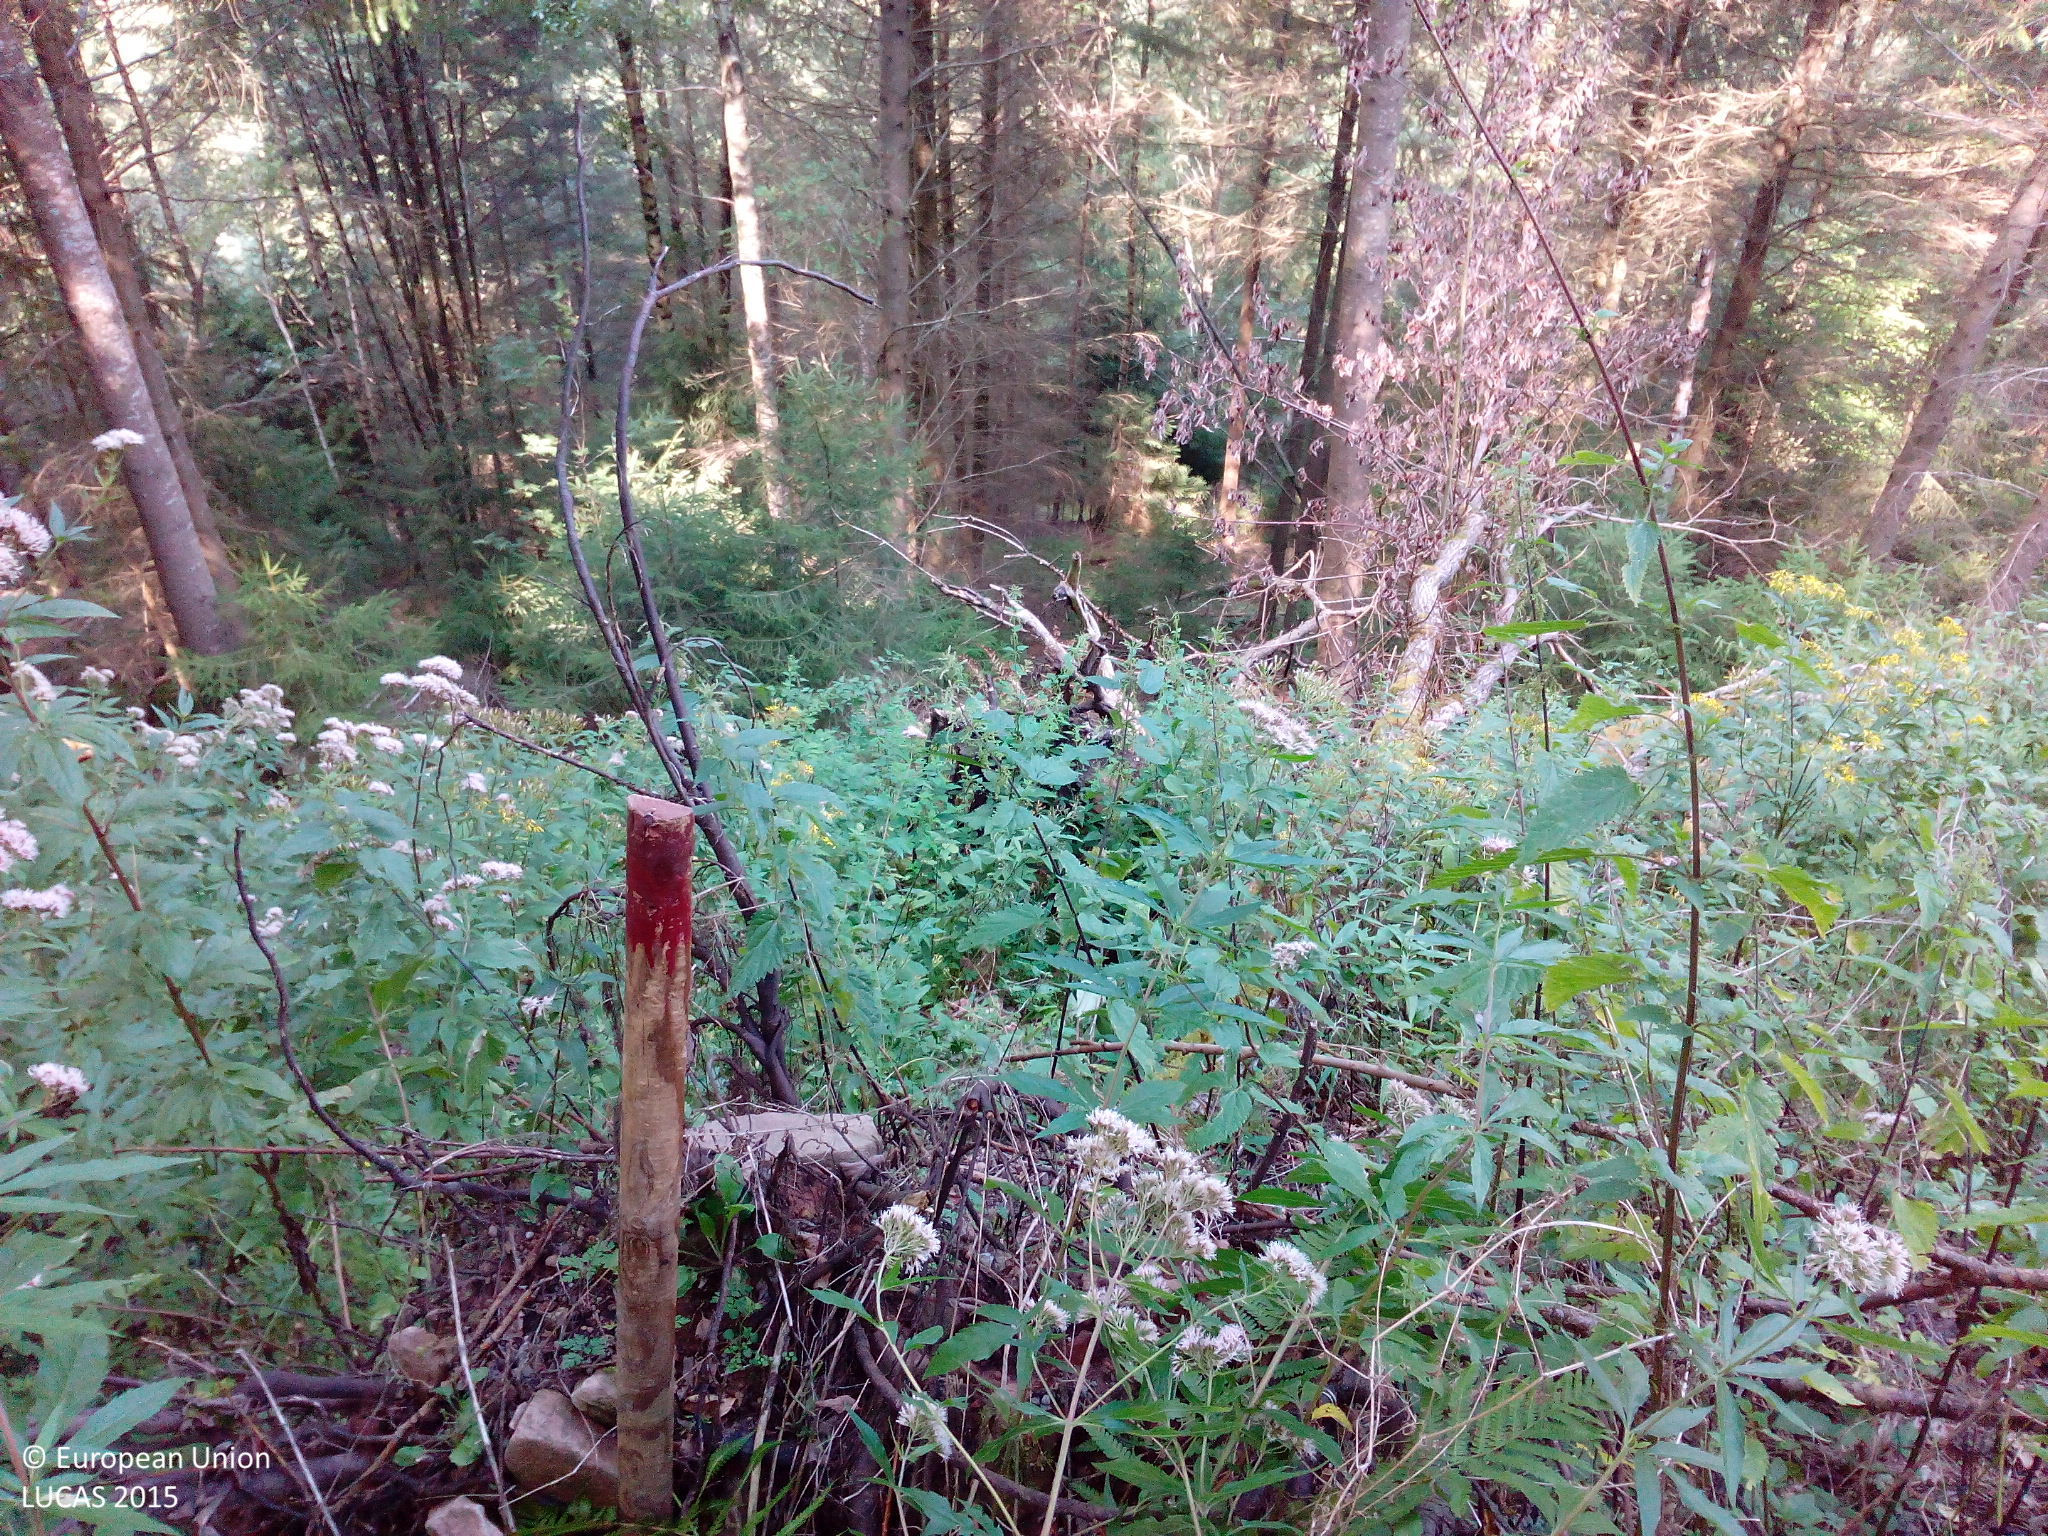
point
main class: Woodland
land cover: Spruce dominated coniferous woodland
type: hemiboreal forest and nemoral coniferous forest and mixed broadleaved-coniferous forest
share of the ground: > 75 %
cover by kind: coniferous forest trees 90 %, broadleaved forest trees 5 %, herbaceous plants 5 %
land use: Forestry
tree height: > 5 m
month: August
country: DE
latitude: 48.7901
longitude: 8.5714
